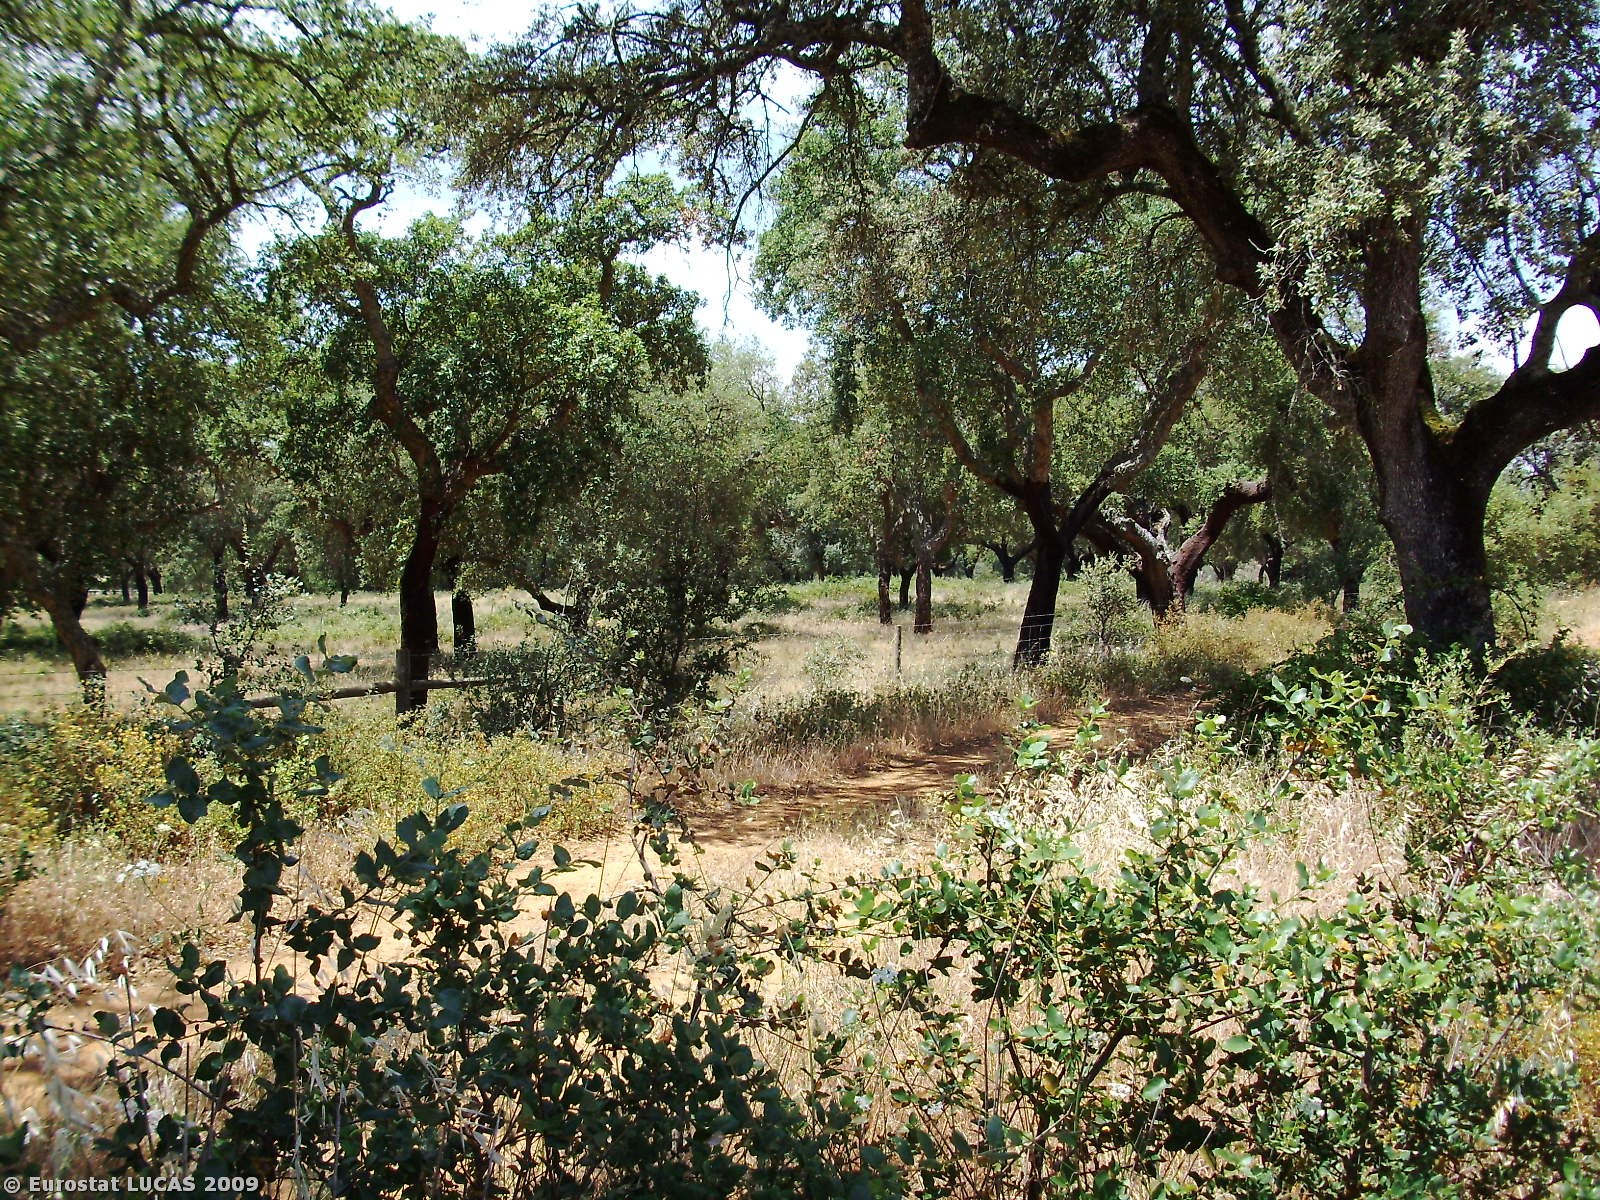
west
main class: Grassland
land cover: Grassland with sparse tree/shrub cover
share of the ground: 50 - 75 %
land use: Fallow land
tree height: > 5 m
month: June
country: PT
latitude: 39.1453
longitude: -7.3817
